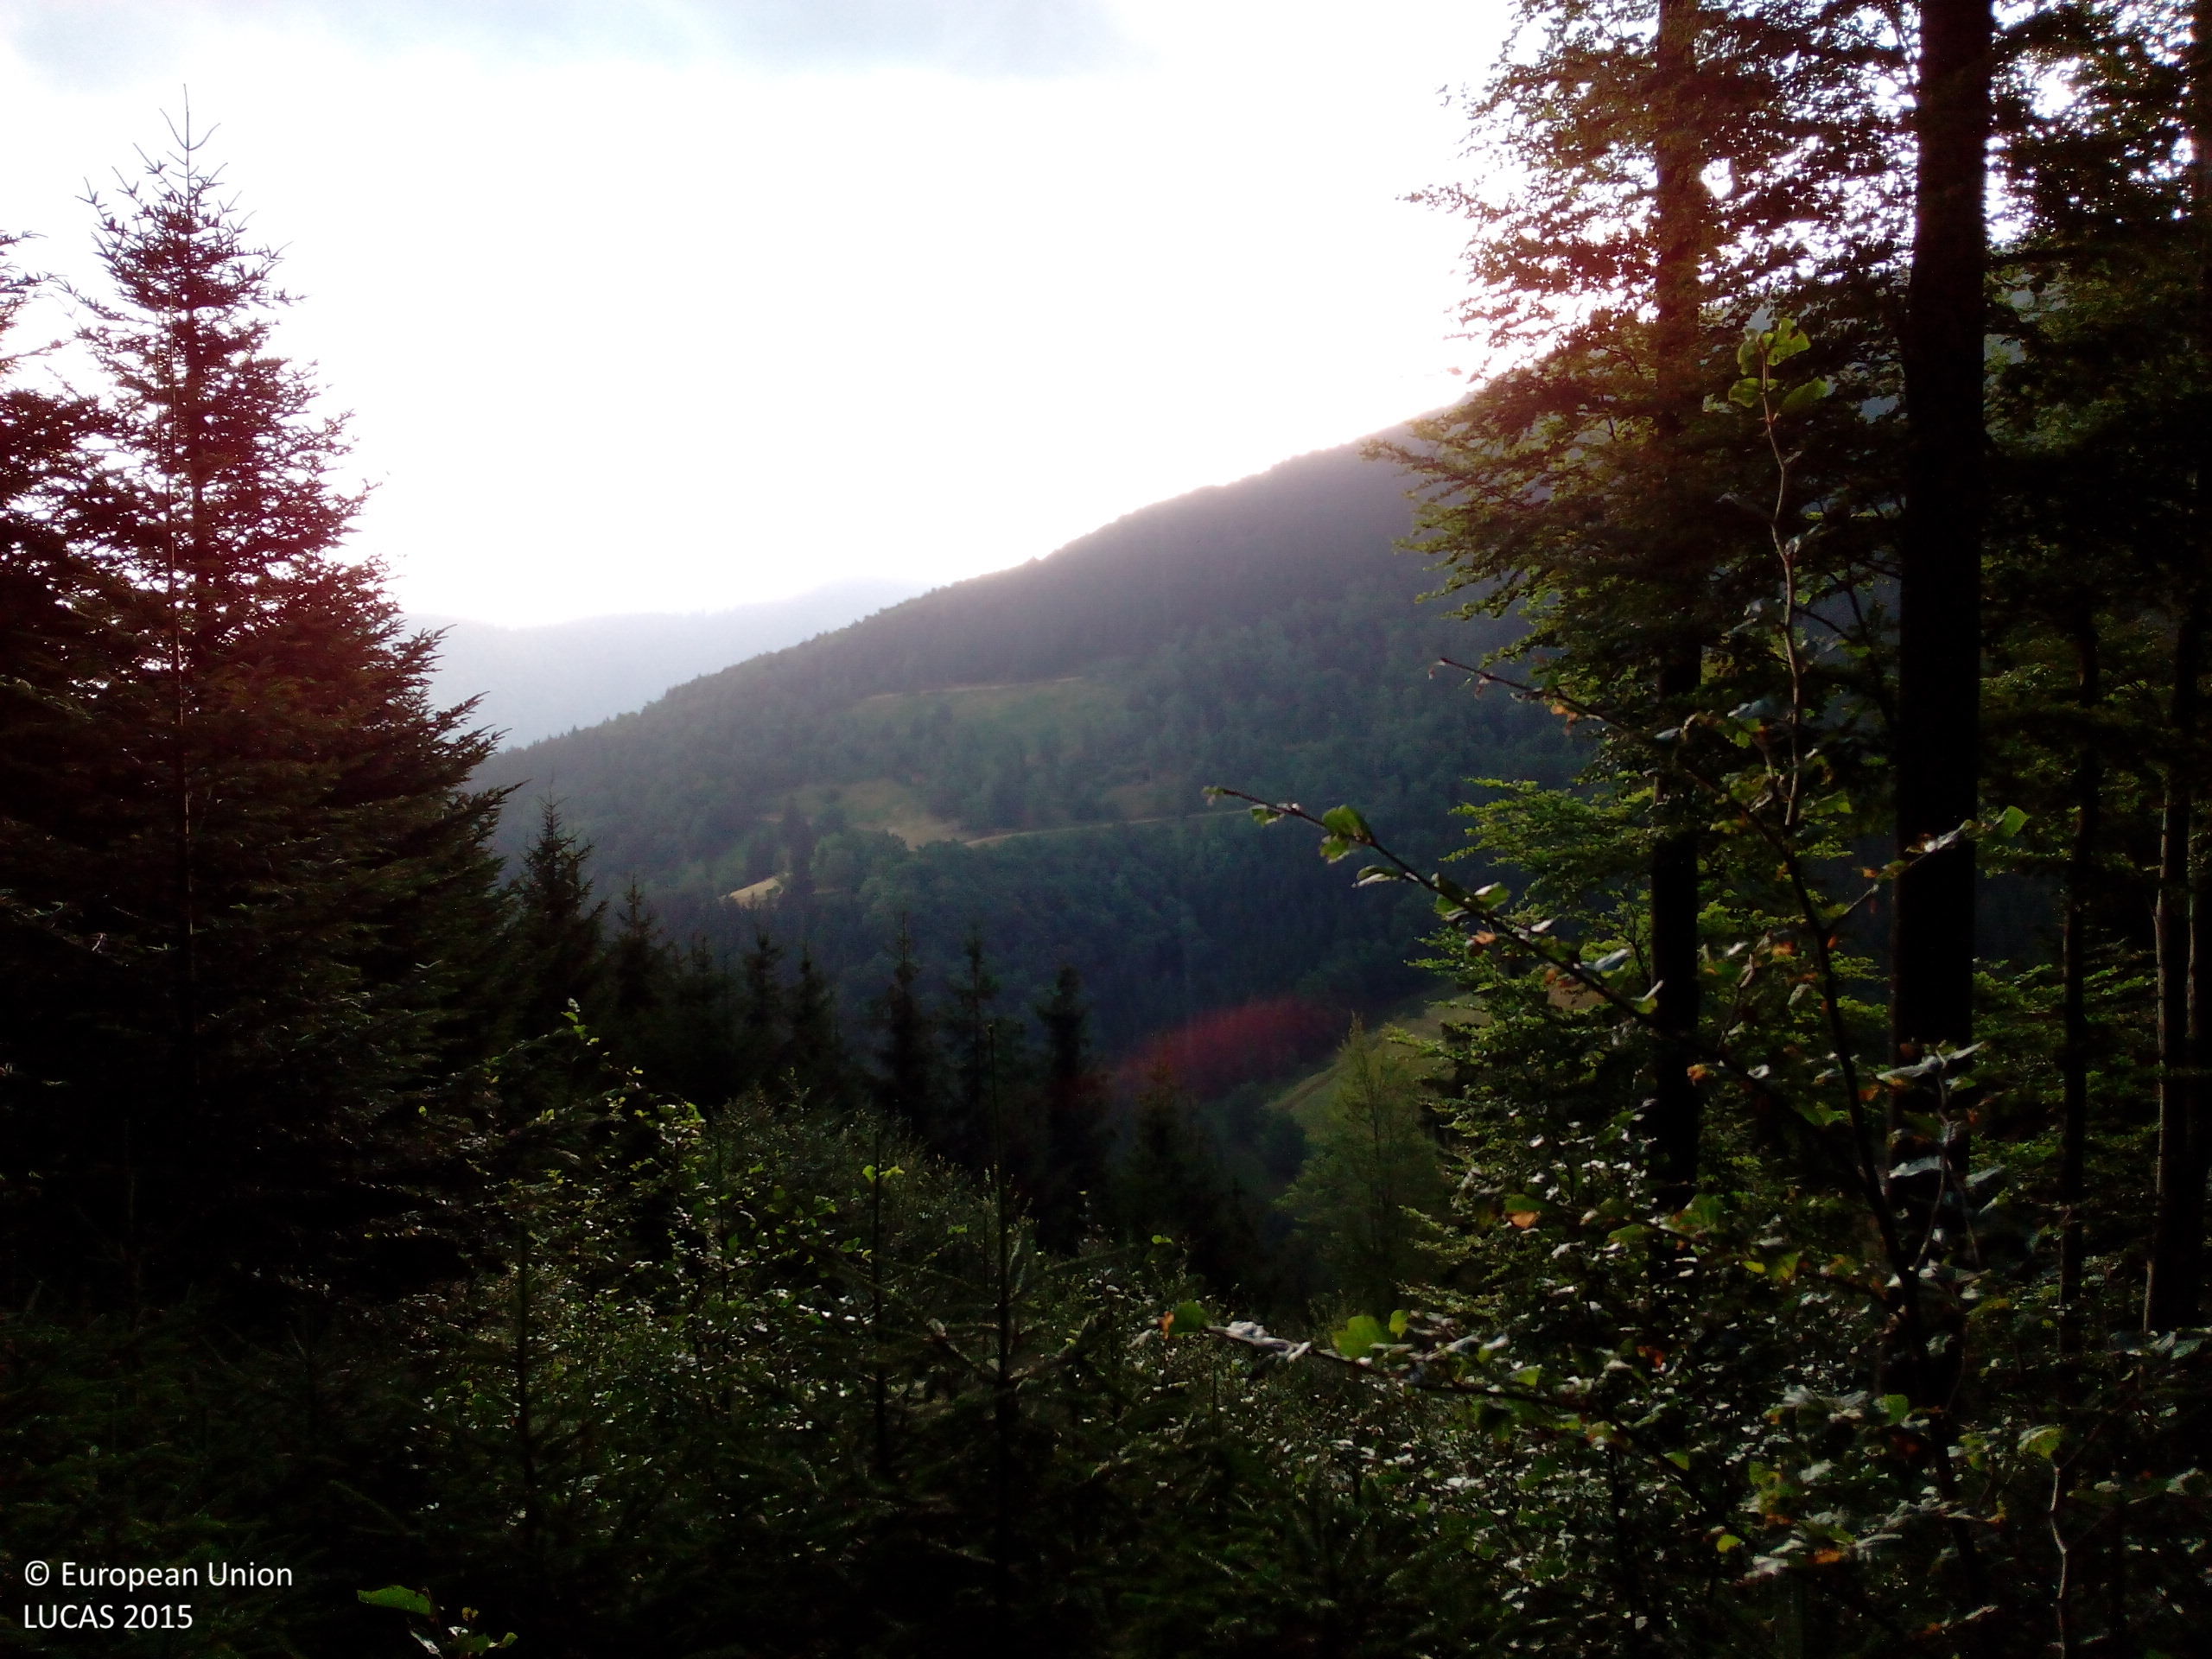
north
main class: Woodland
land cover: Spruce dominated mixed woodland
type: hemiboreal forest and nemoral coniferous forest and mixed broadleaved-coniferous forest
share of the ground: > 75 %
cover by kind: broadleaved forest trees 50 %, coniferous forest trees 35 %, unconsolidated bare surface 10 %, shrubs 5 %
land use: Forestry
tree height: < 5 m
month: July
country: DE
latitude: 48.1353
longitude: 8.1063
